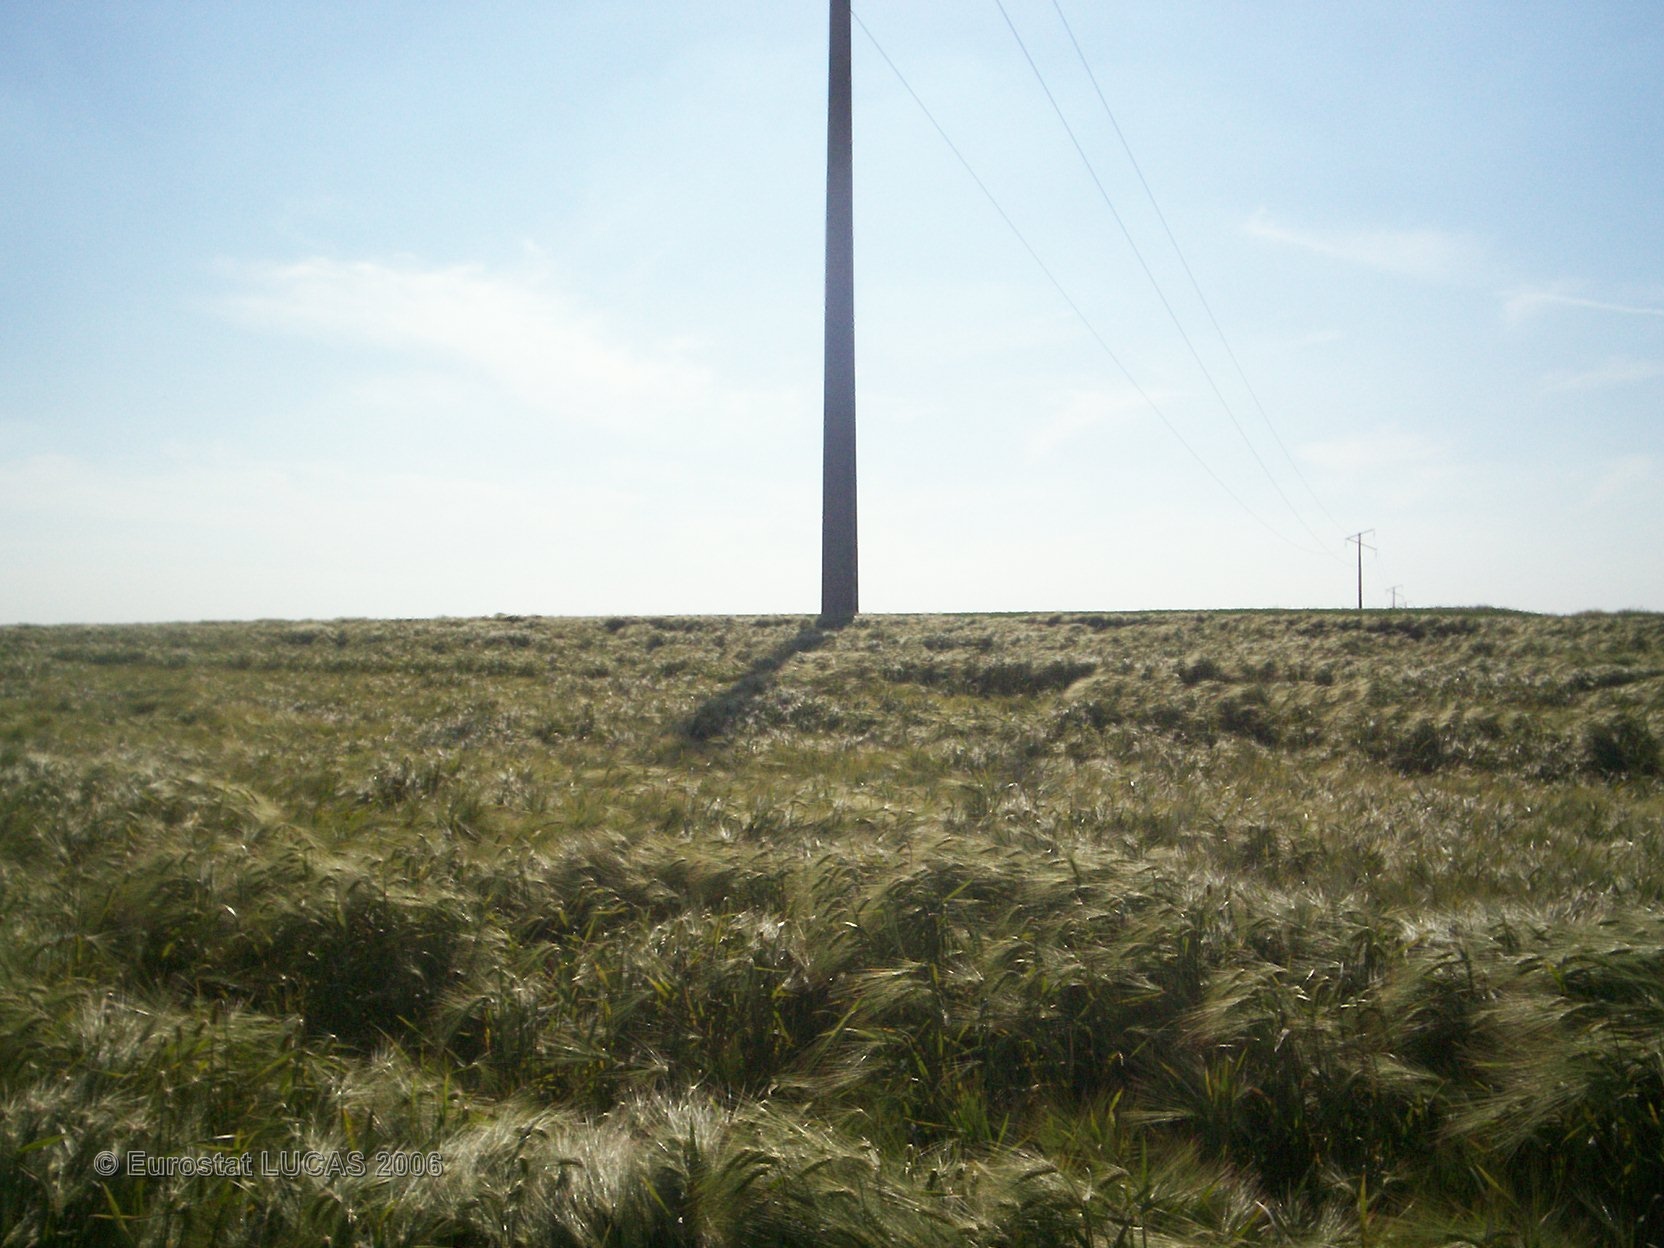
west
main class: Cropland
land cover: Barley
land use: Agriculture (excluding fallow land and kitchen gardens)
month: June
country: FR
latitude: 49.5495
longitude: 2.6493
